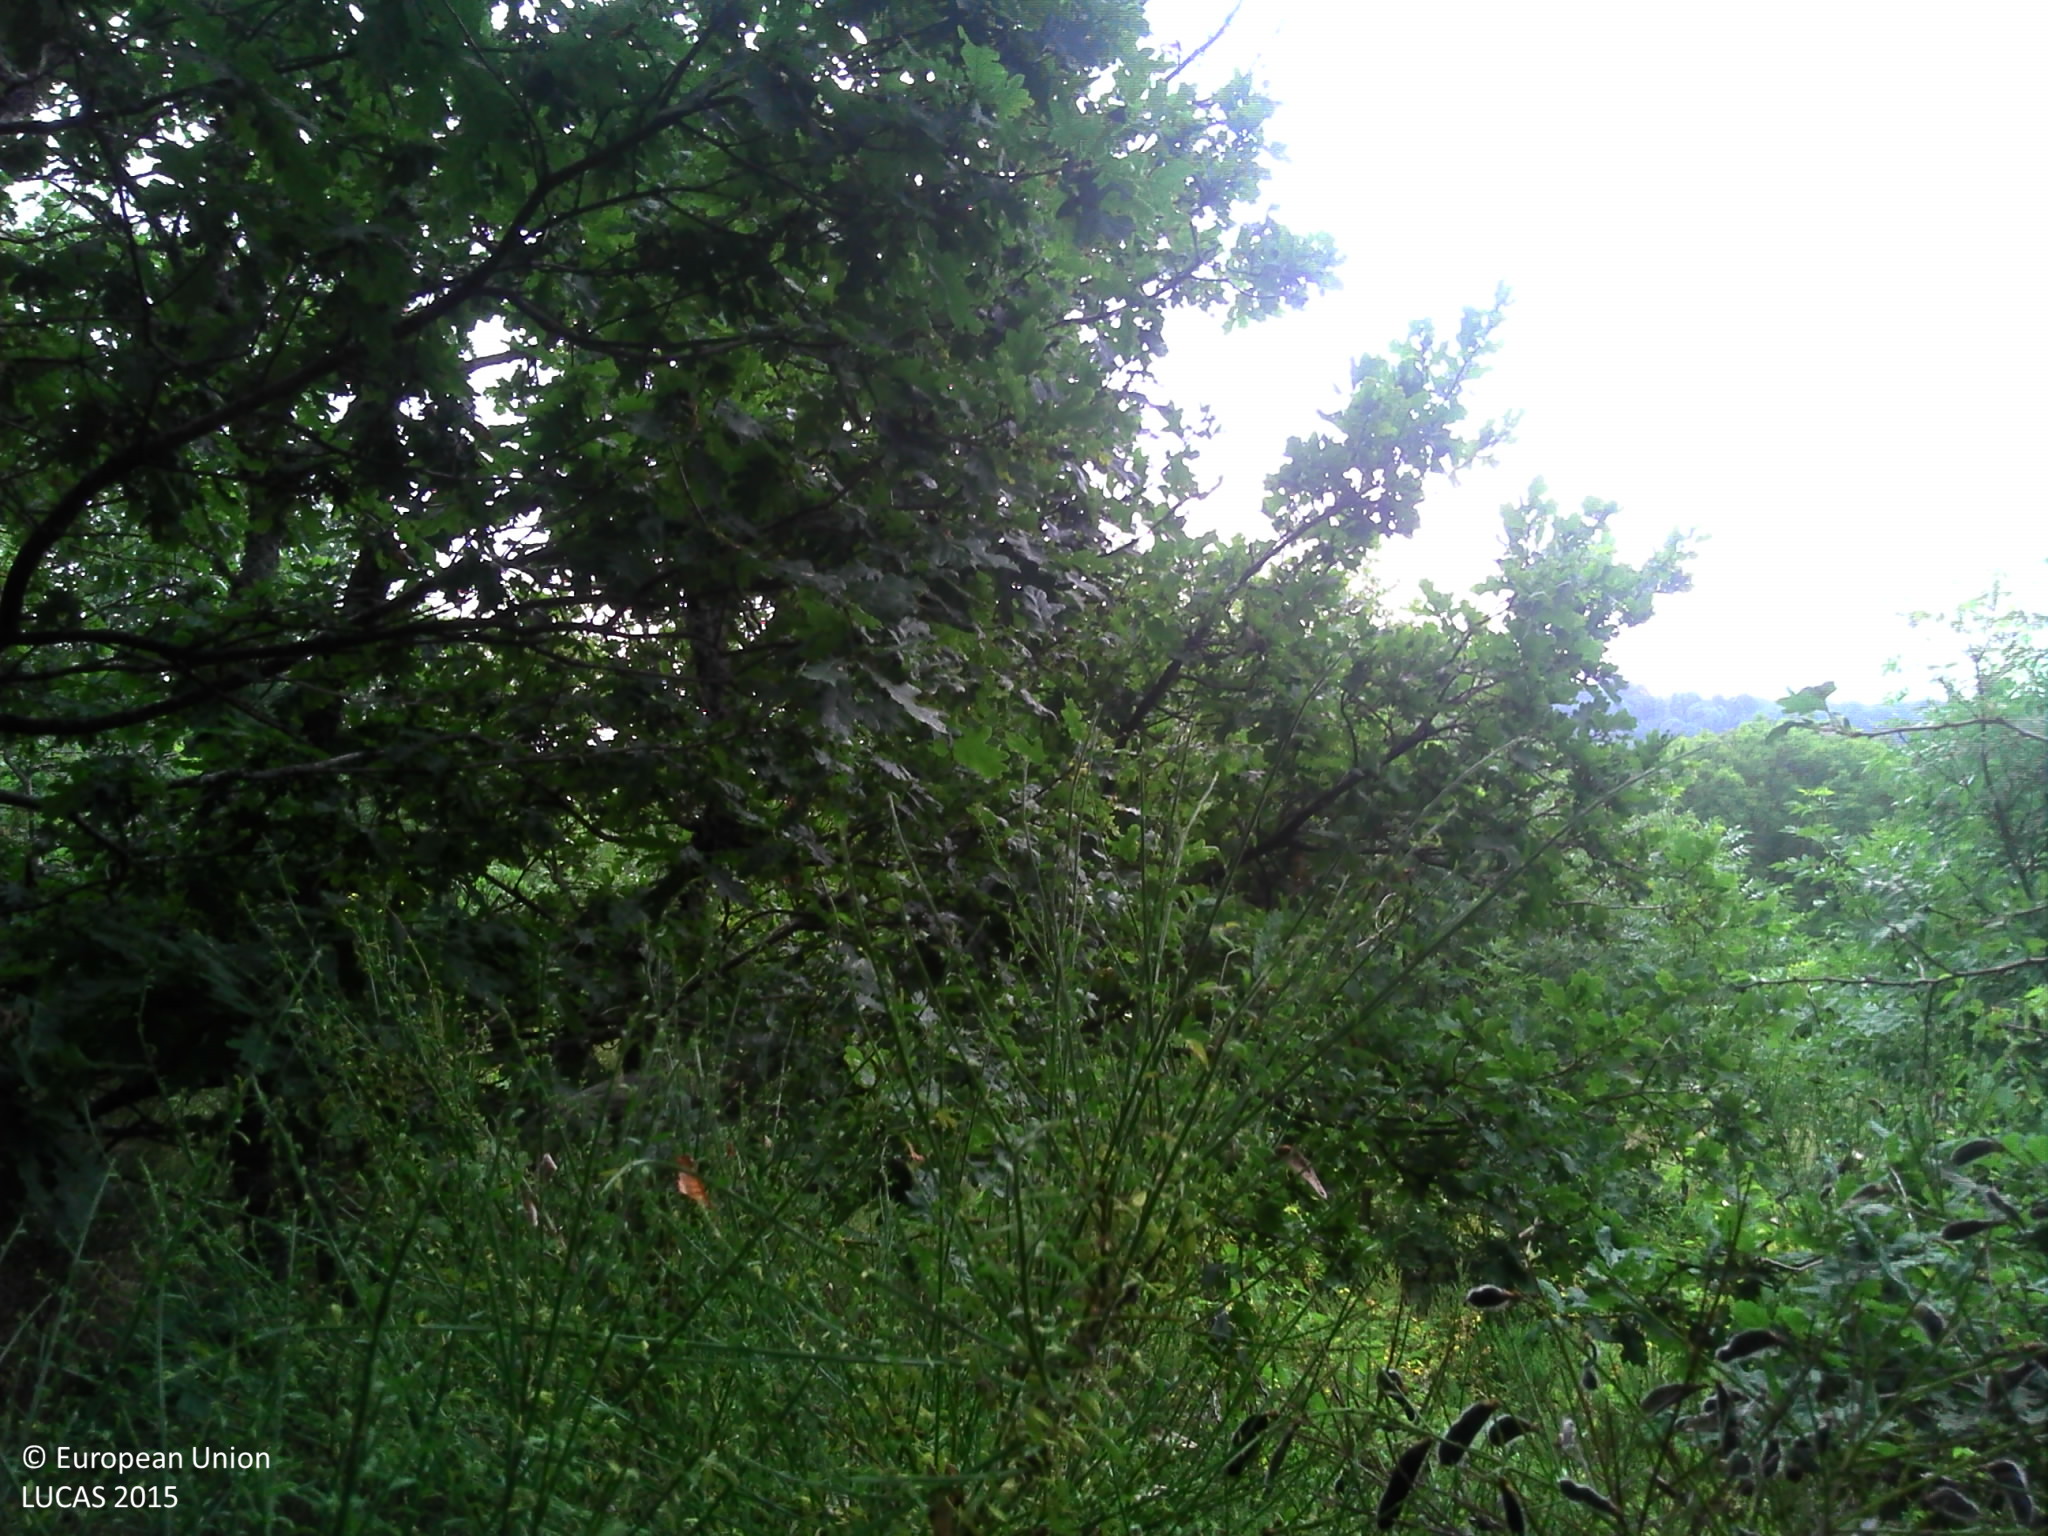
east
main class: Woodland
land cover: Broadleaved woodland
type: acidophilous oak and oak-birch forest
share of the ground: > 75 %
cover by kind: herbaceous plants 40 %, broadleaved forest trees 30 %, shrubs 25 %, lichens and mosses 5 %
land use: Forestry
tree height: > 5 m
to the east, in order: Broadleaved woodland; Shrubland with sparse tree cover; Grassland without tree/shrub cover; Lines of trees; Grassland without tree/shrub cover; Broadleaved woodland; Grassland without tree/shrub cover; Managed hedges; Grassland without tree/shrub cover; Managed hedges; Broadleaved woodland
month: July
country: FR
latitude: 45.9244
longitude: 3.0229
